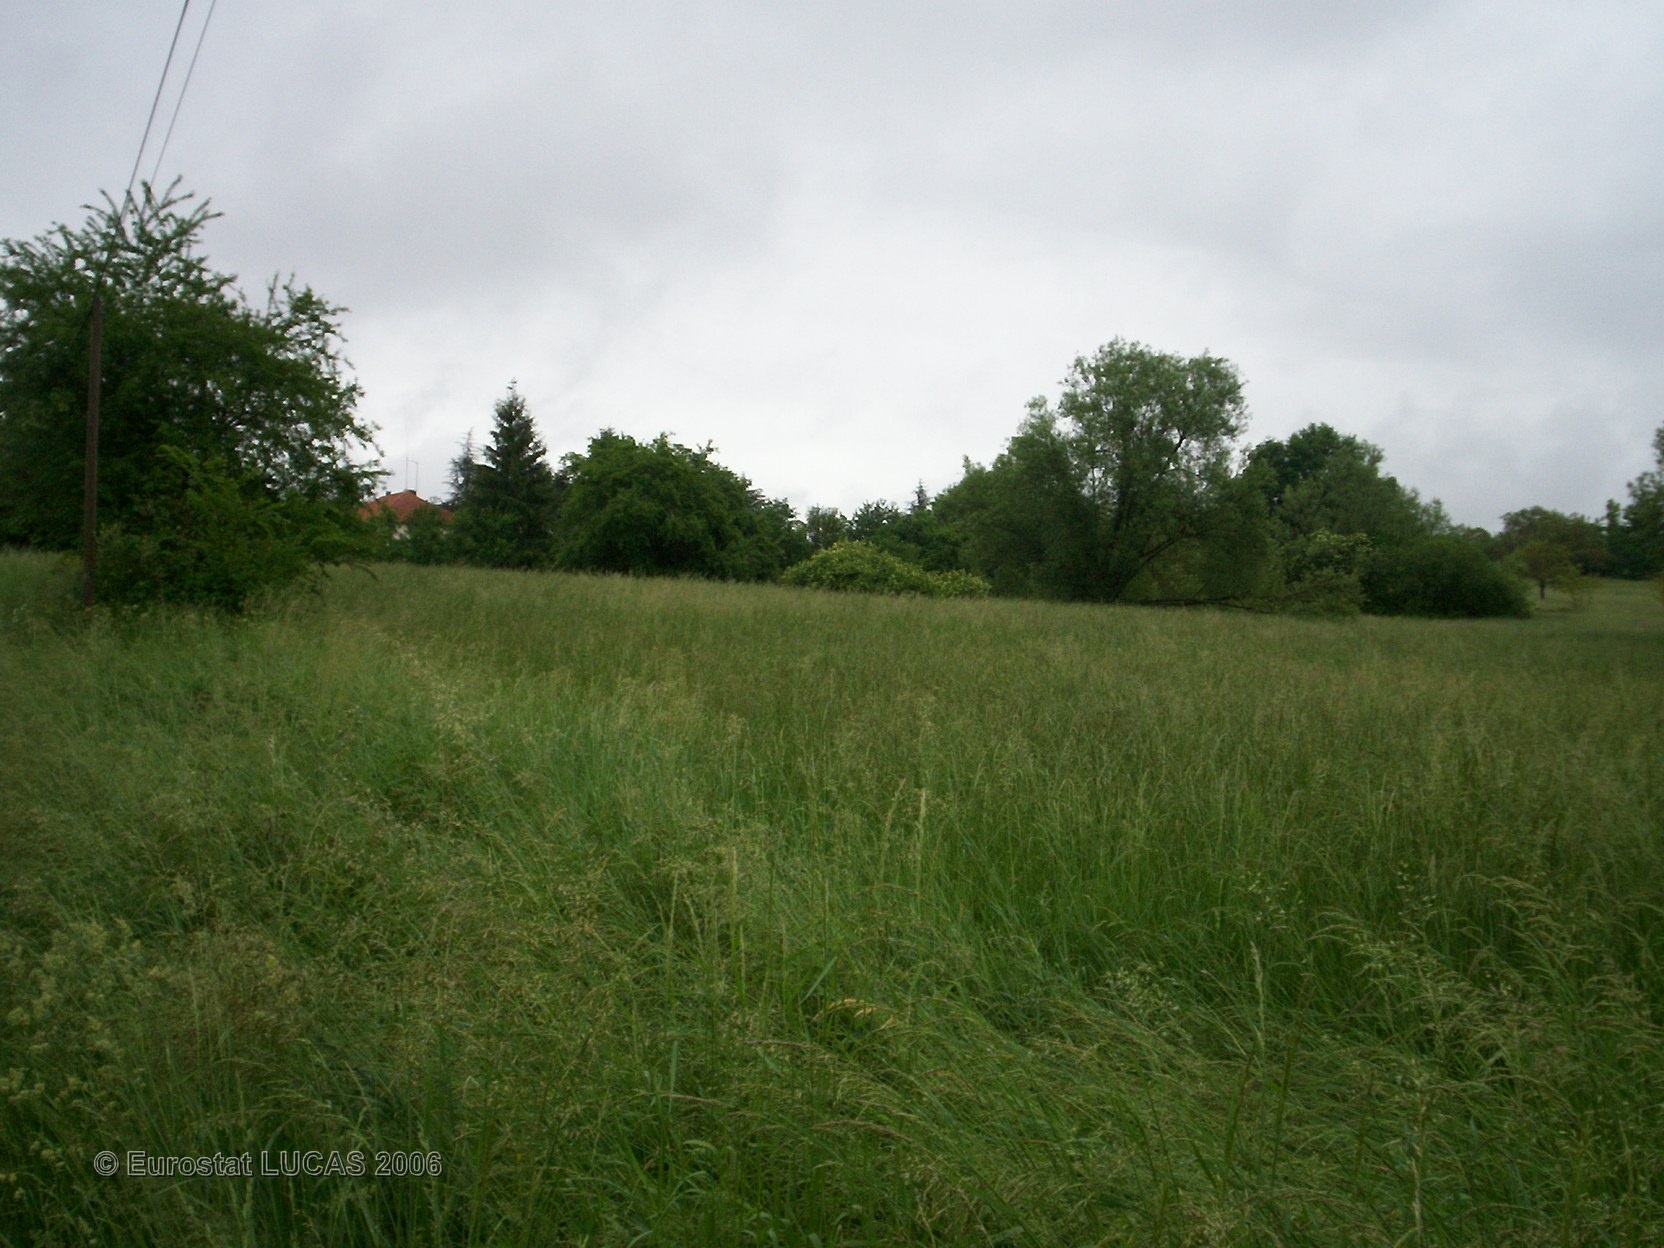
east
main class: Grassland
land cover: Grassland with sparse tree/shrub cover
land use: Agriculture (excluding fallow land and kitchen gardens)
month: May
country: FR
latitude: 44.7339
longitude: 1.3718
